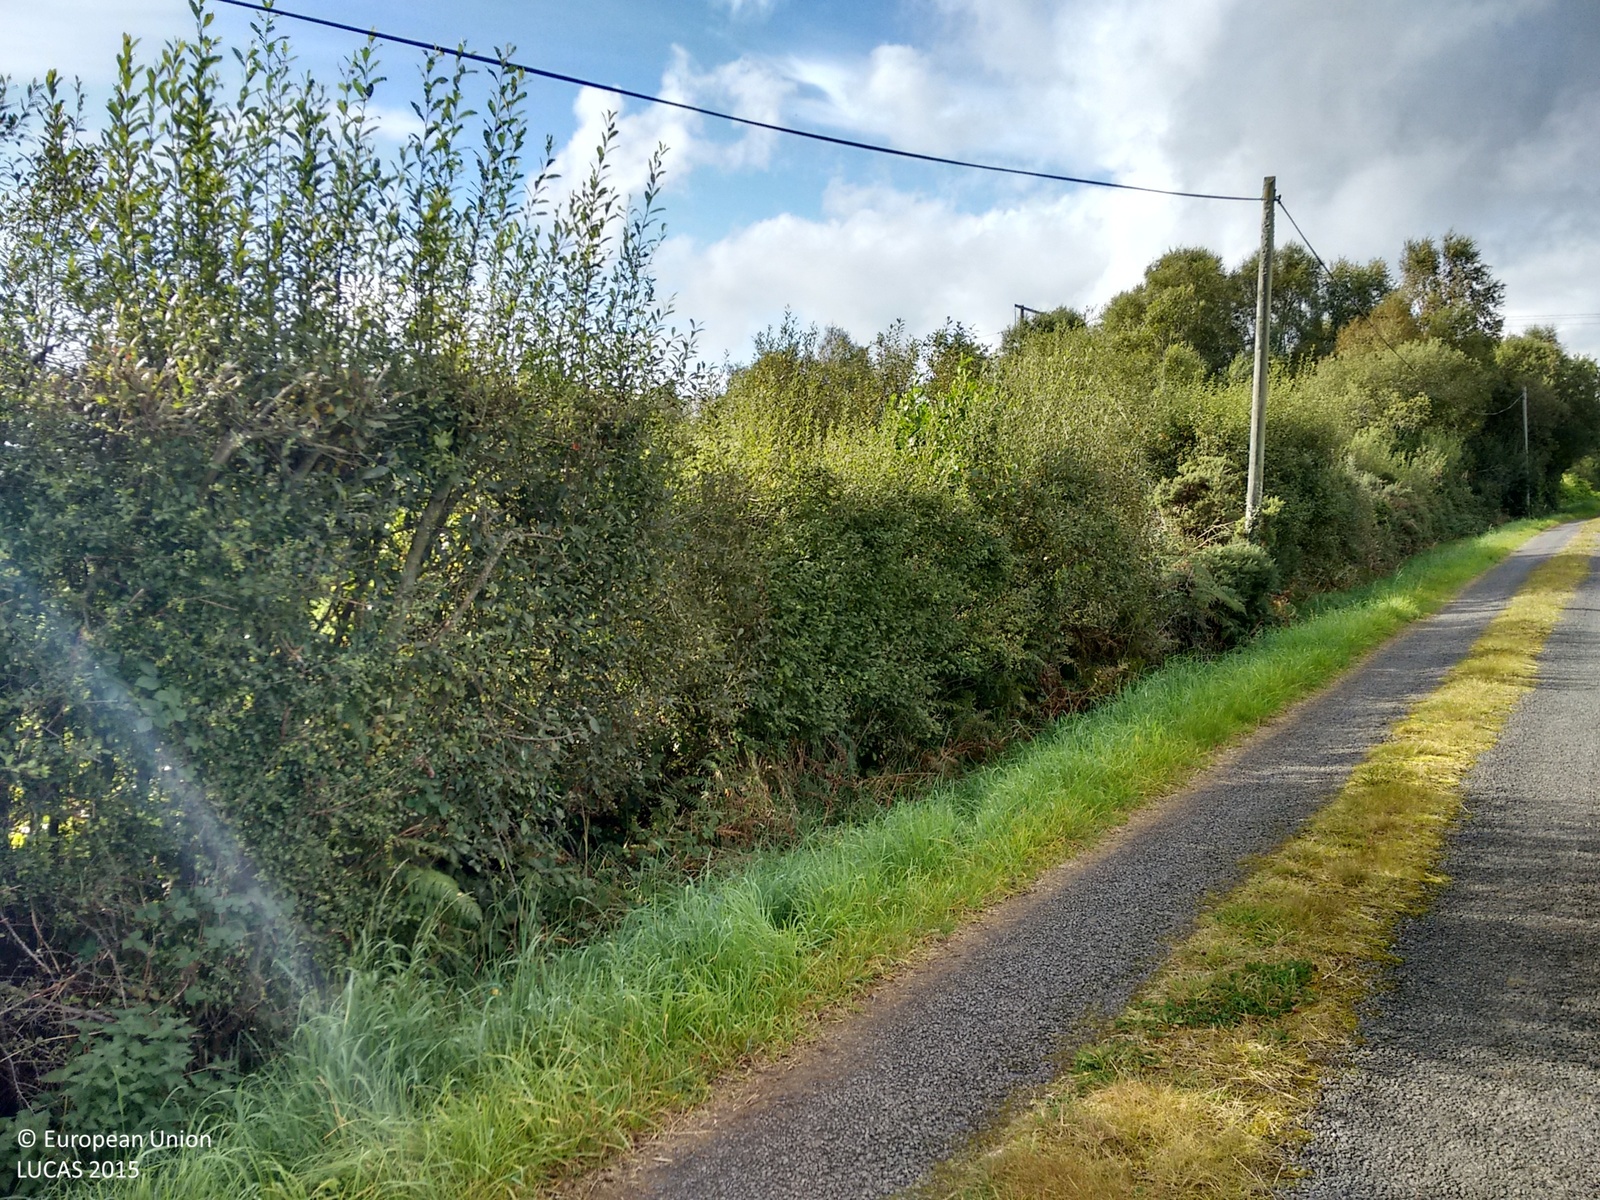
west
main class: Grassland
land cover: Grassland without tree/shrub cover
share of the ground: > 75 %
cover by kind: herbaceous plants 100 %
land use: Agriculture (excluding fallow land and kitchen gardens)
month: October
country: IE
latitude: 53.8358
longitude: -8.0623
